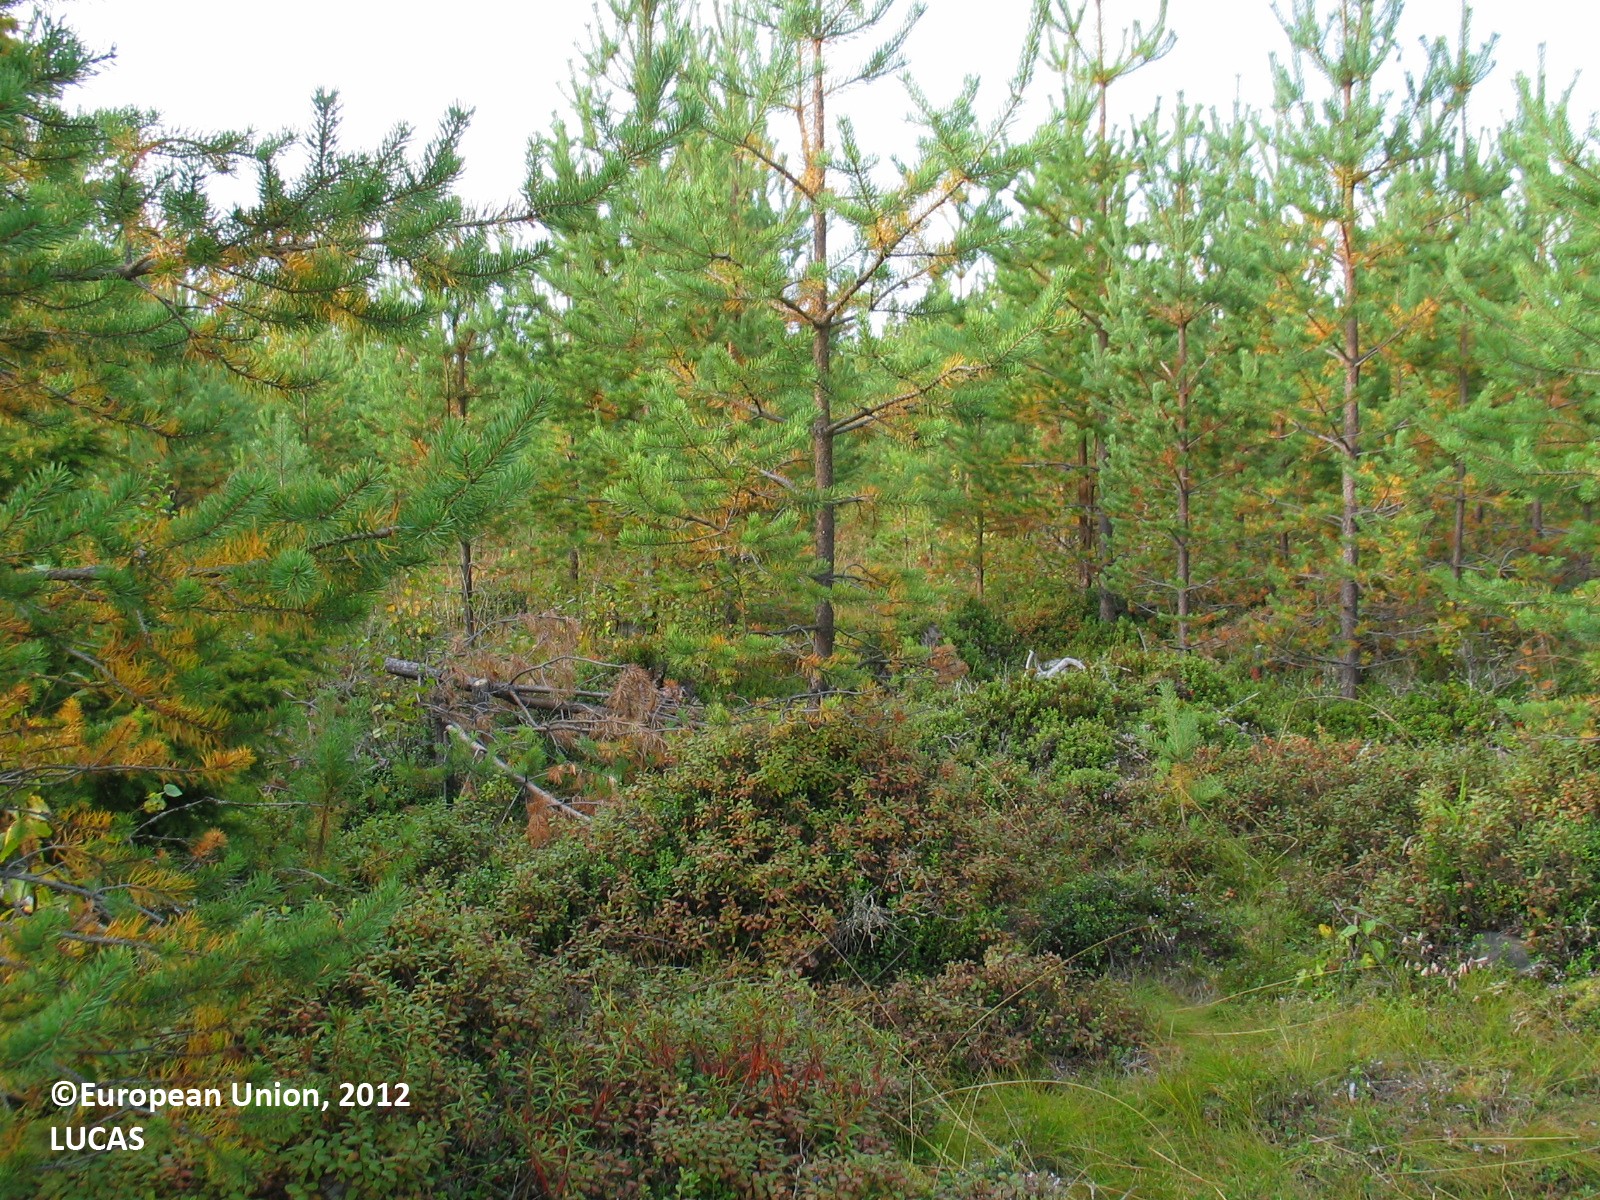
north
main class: Woodland
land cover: Pine dominated coniferous woodland
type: boreal forest
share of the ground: 50 - 75 %
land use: Forestry
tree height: < 5 m
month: September
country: FI
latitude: 65.2517
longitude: 25.5601
